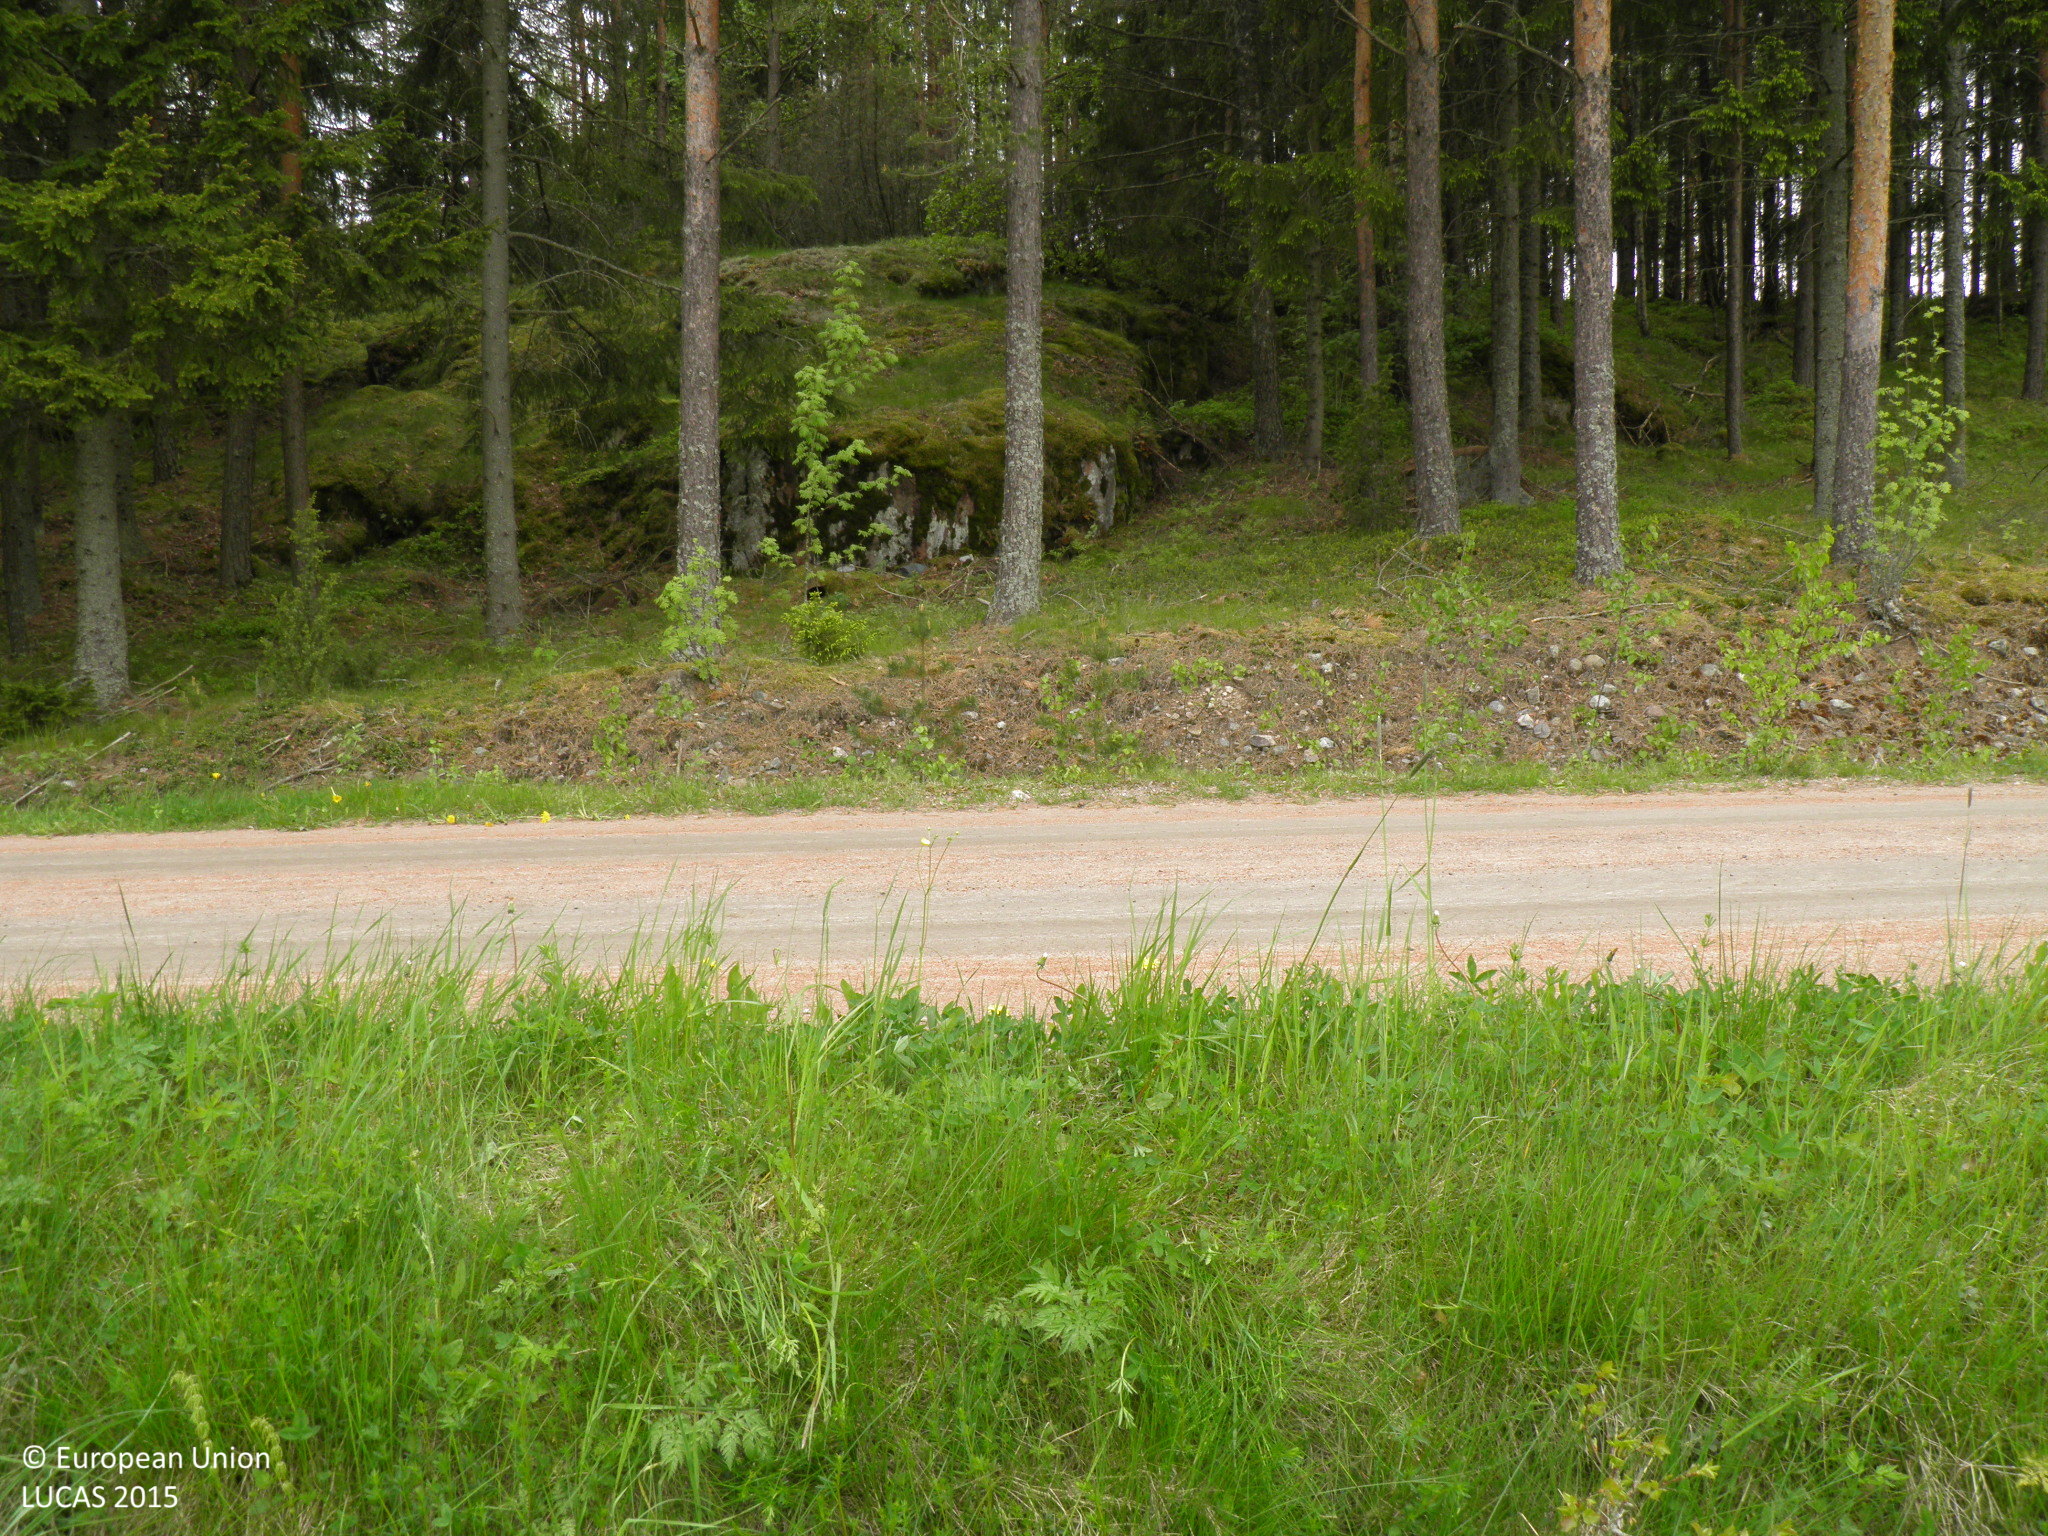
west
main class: Cropland
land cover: Oats
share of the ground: 50 - 75 %
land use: Agriculture (excluding fallow land and kitchen gardens)
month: June
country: FI
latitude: 60.5031
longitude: 22.6538
